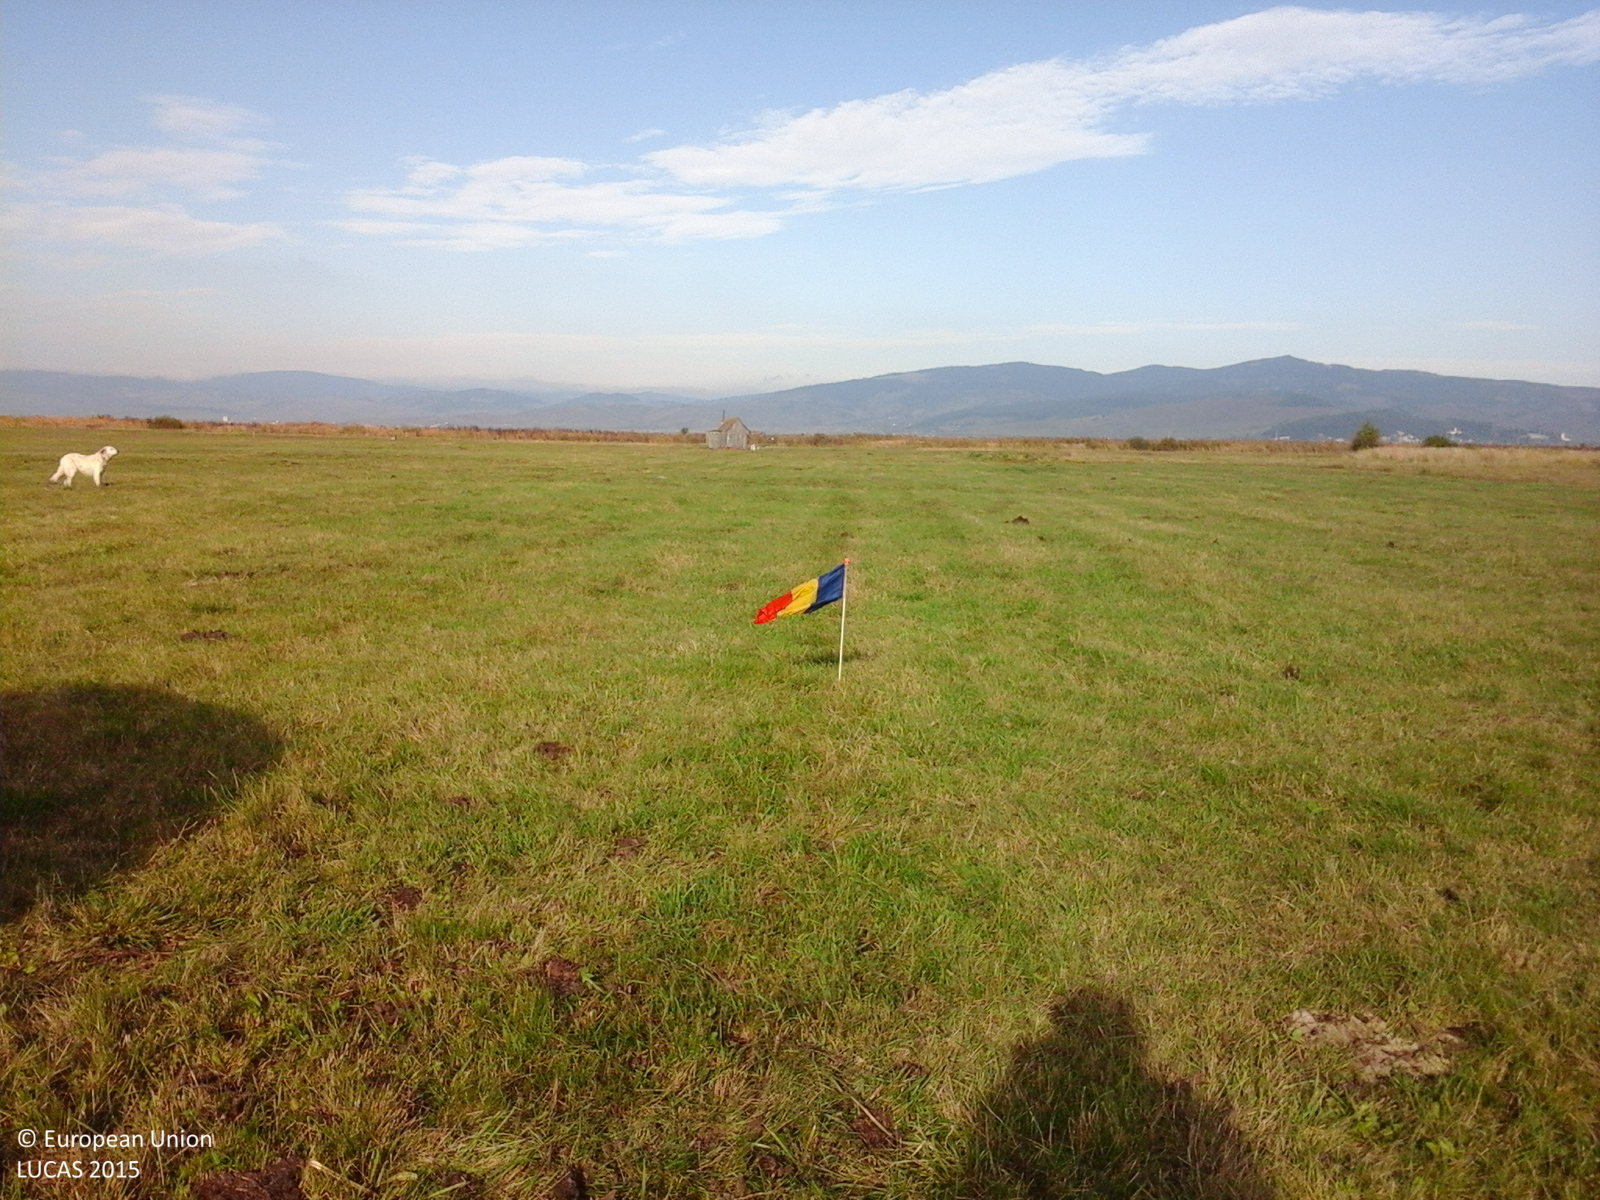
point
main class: Grassland
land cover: Grassland without tree/shrub cover
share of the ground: > 75 %
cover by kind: herbaceous plants 100 %
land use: Agriculture (excluding fallow land and kitchen gardens)
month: October
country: RO
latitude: 46.7218
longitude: 25.4564
